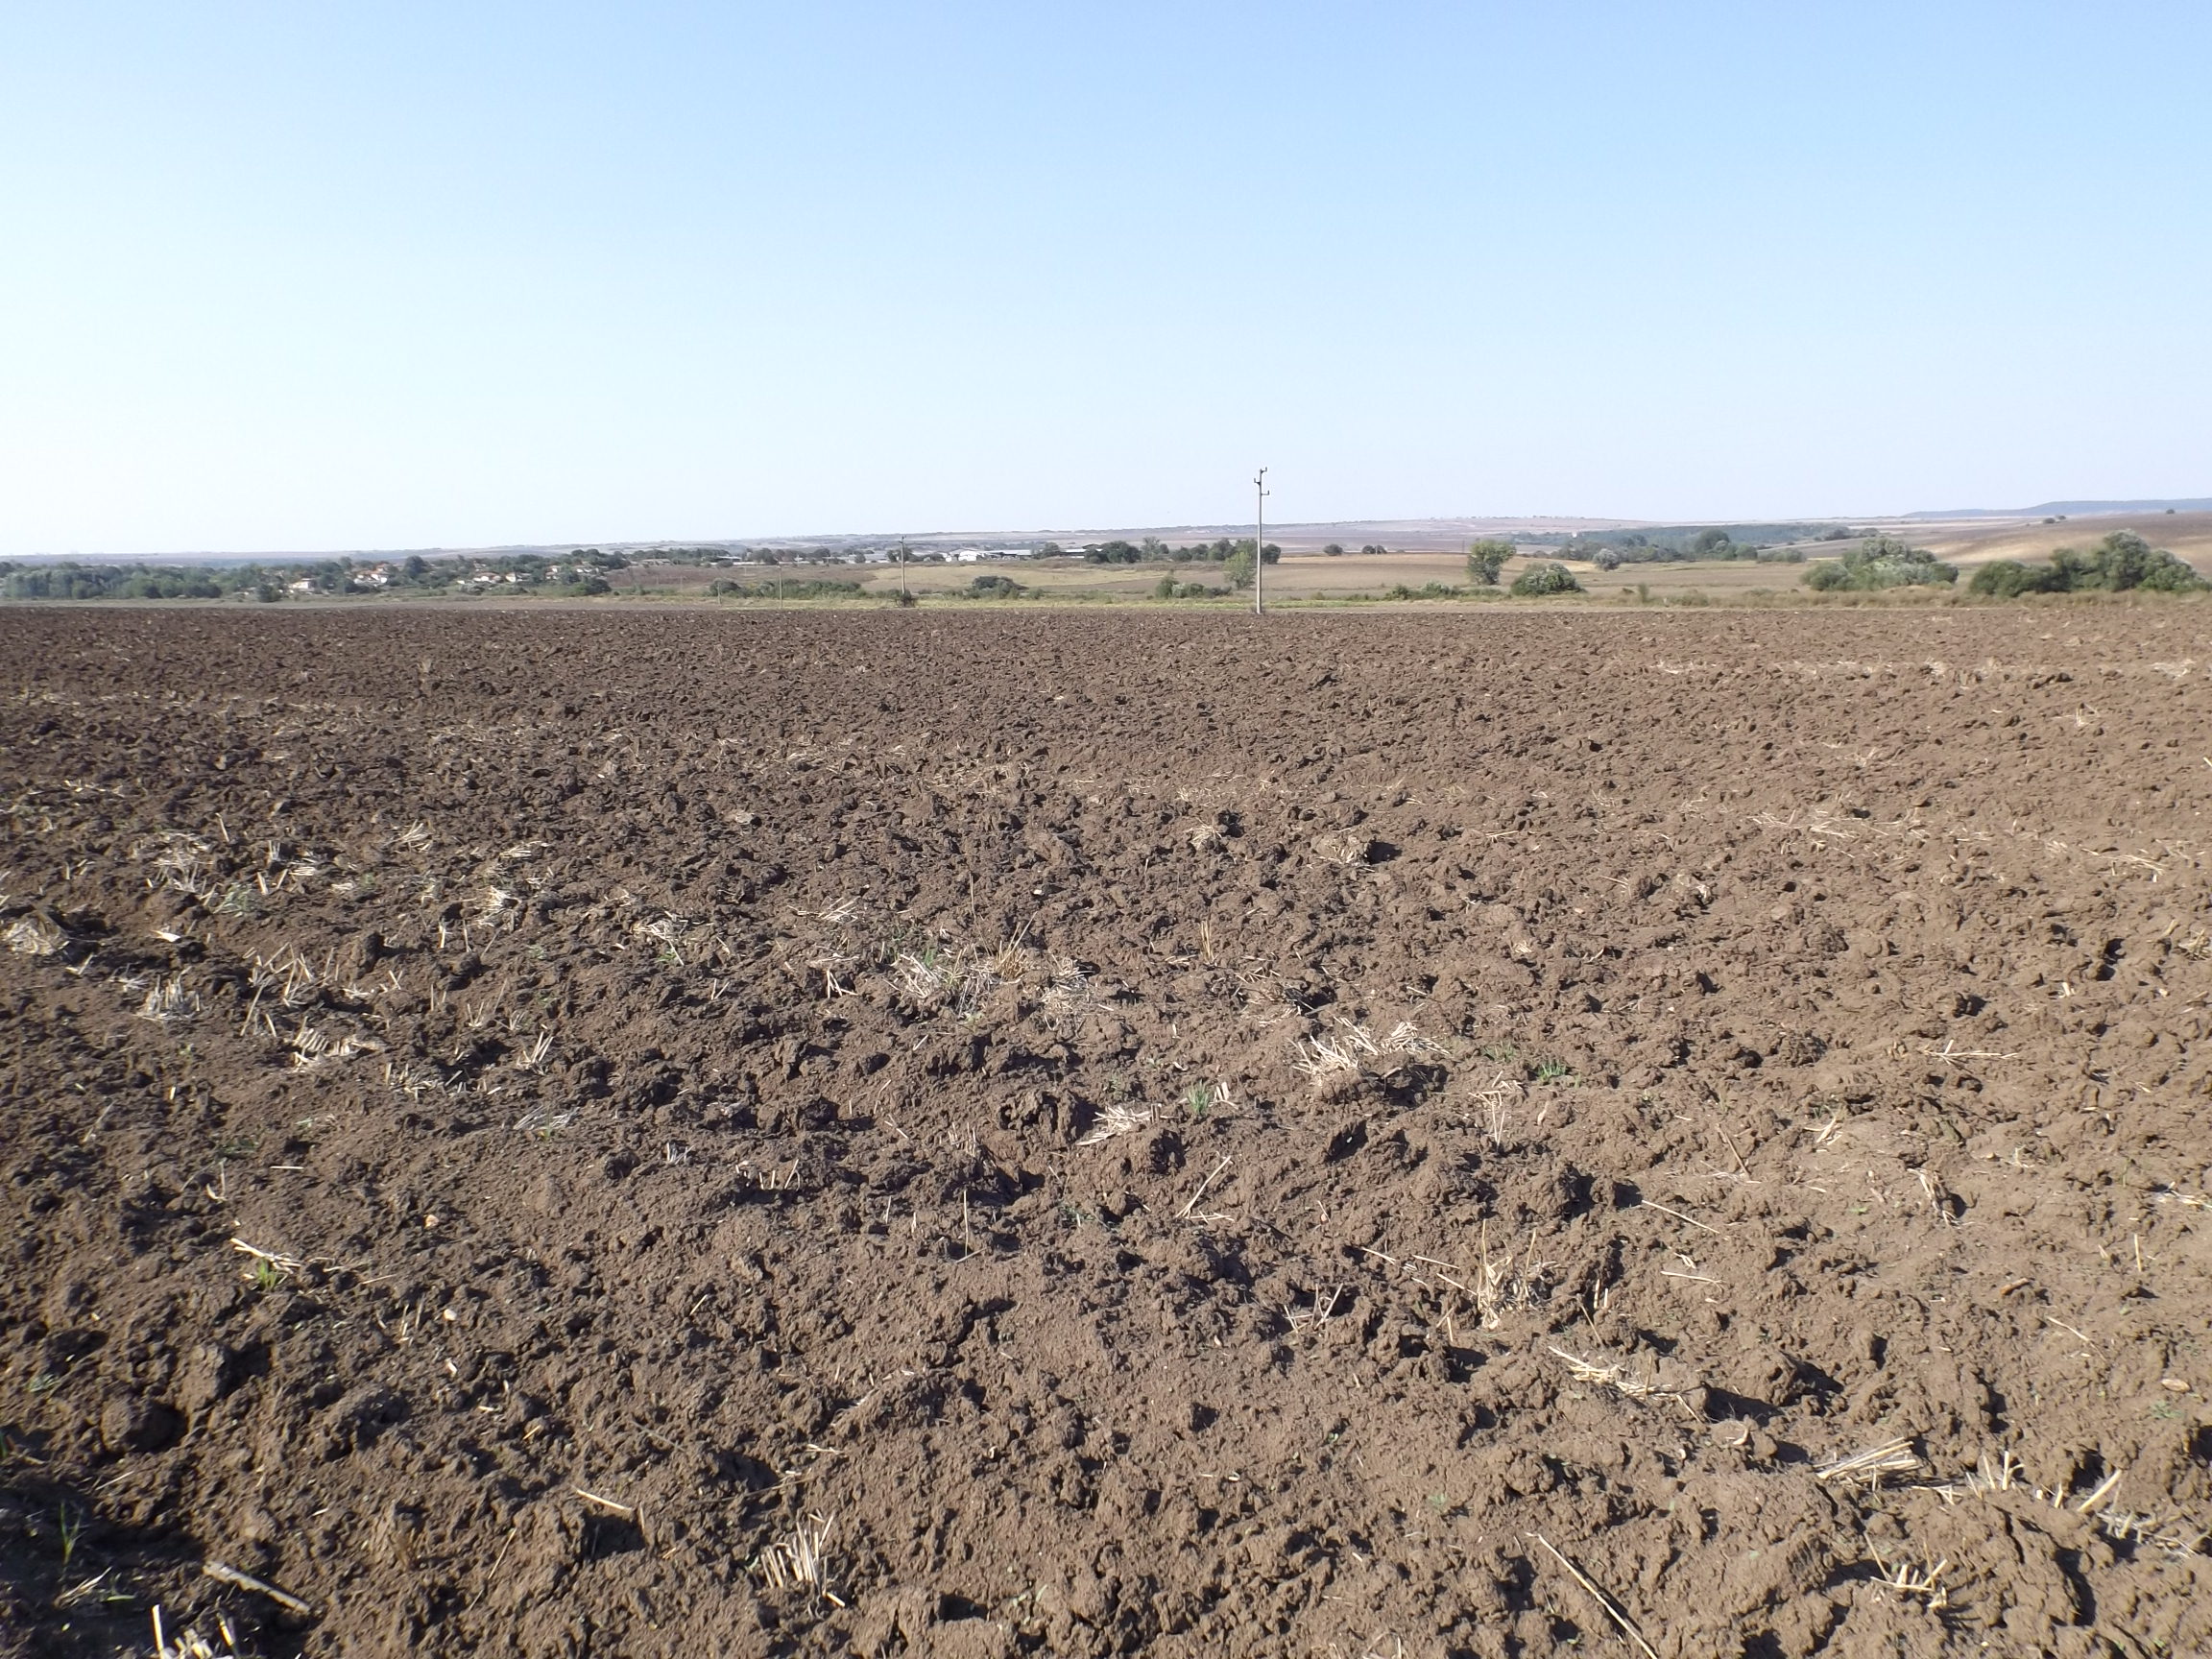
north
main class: Cropland
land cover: Common wheat
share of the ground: < 10 %
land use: Agriculture (excluding fallow land and kitchen gardens)
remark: Harvested field
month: August
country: BG
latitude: 43.1257
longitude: 27.3933
